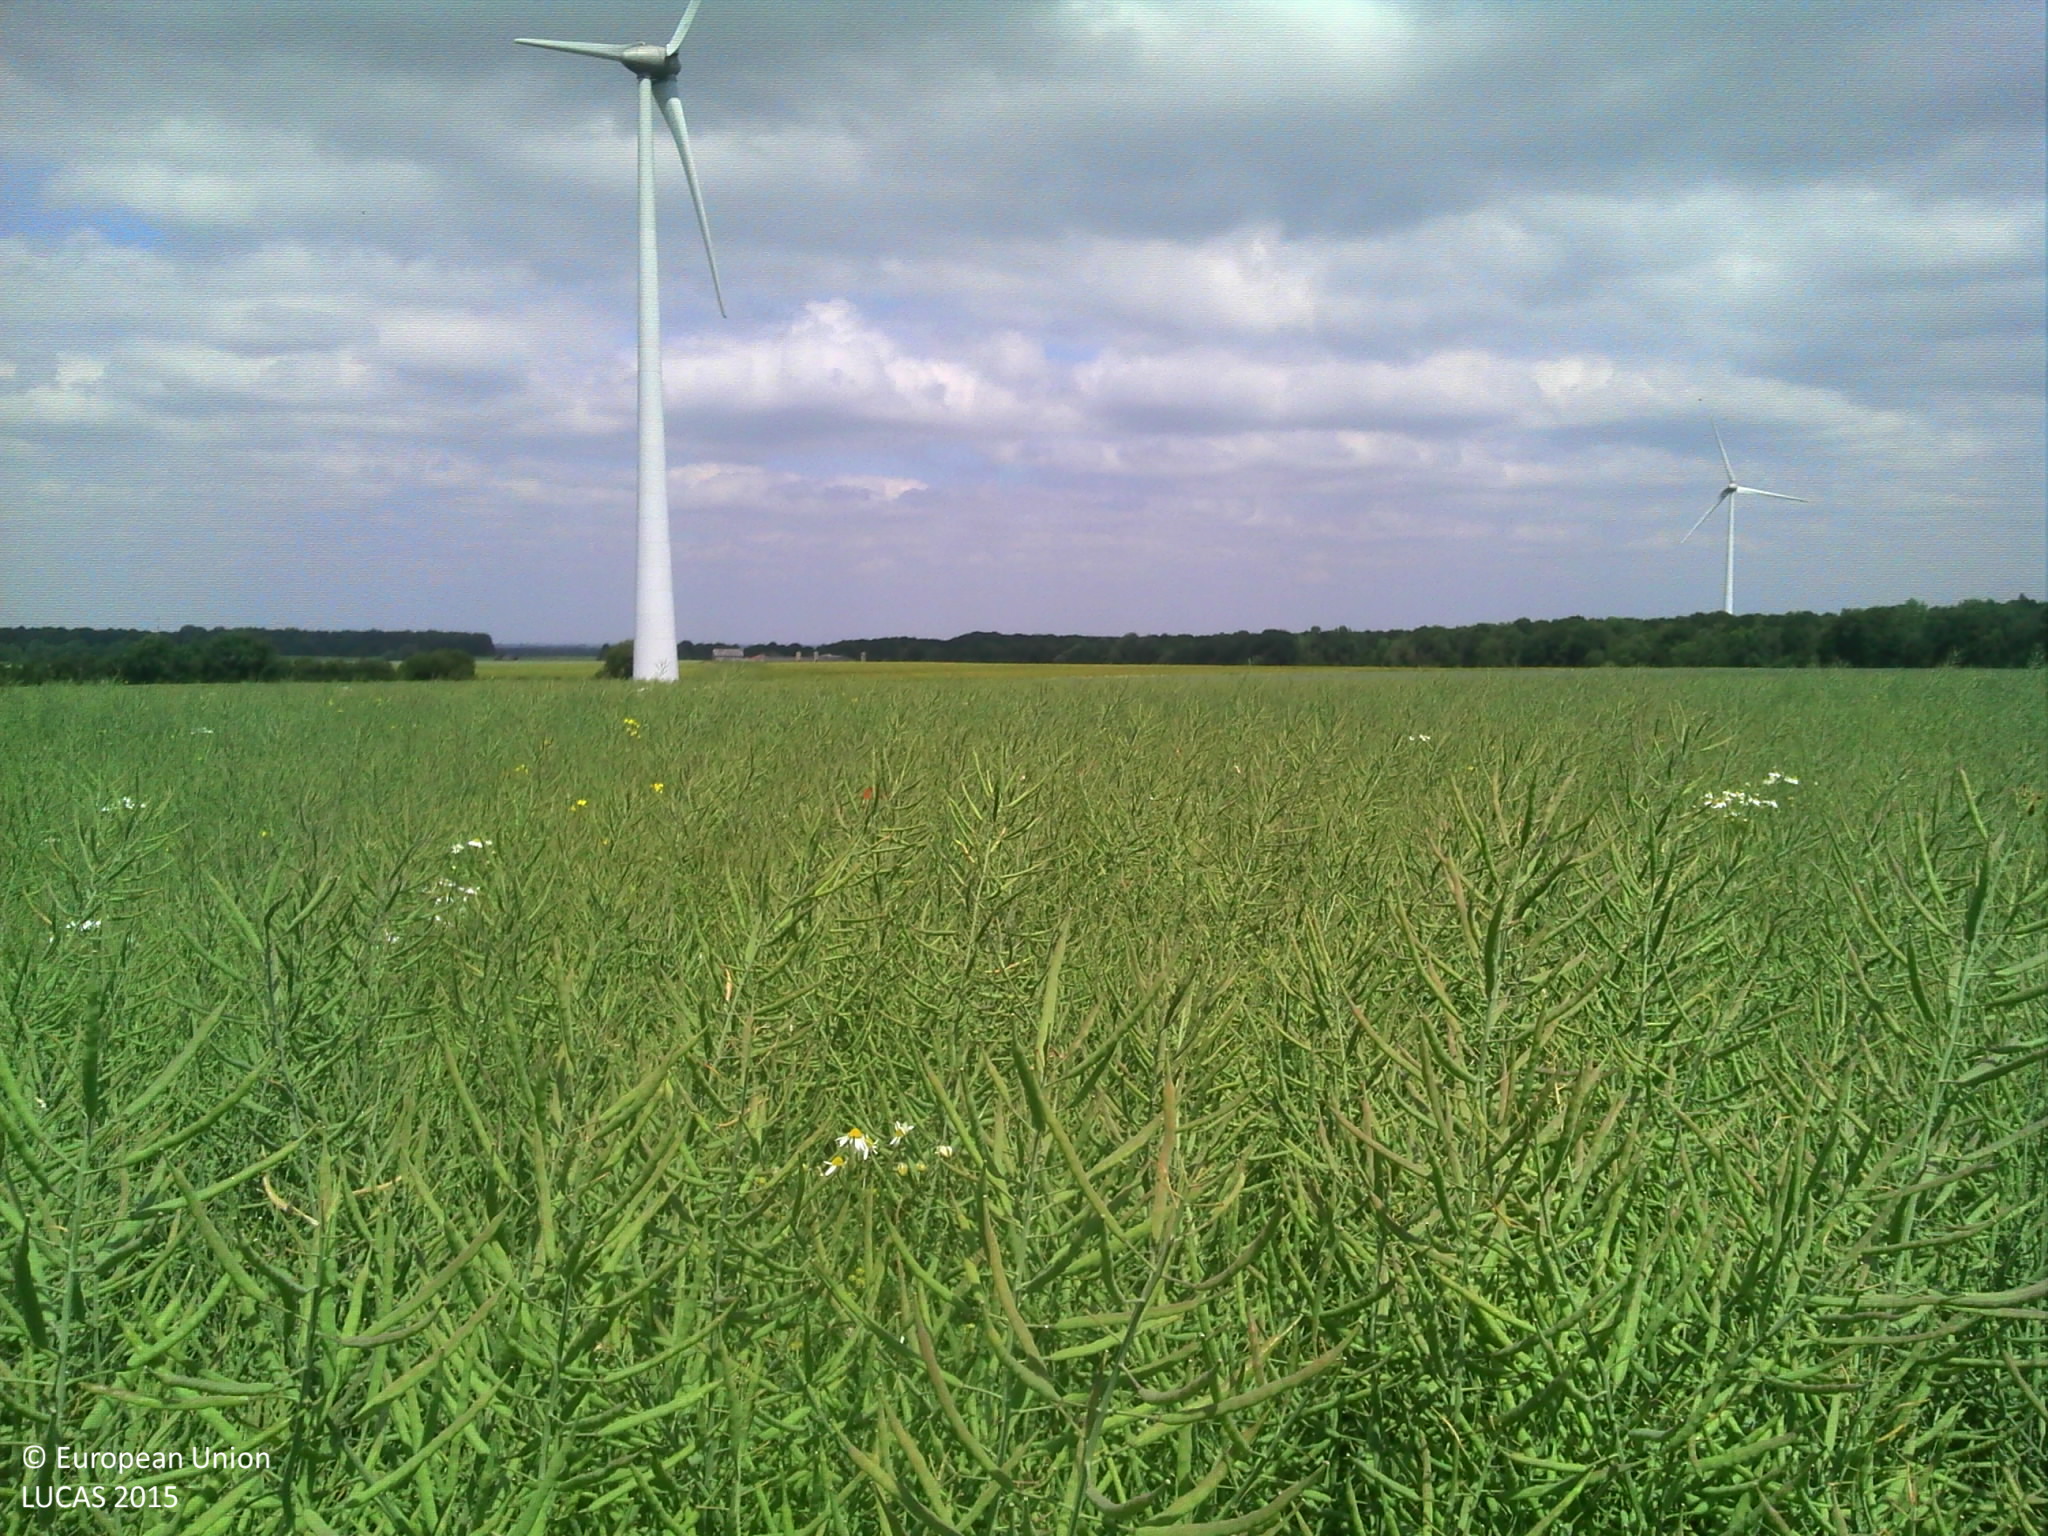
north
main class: Cropland
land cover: Rape and turnip rape
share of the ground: > 75 %
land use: Agriculture (excluding fallow land and kitchen gardens)
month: June
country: BE
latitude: 50.3646
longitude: 4.6402
